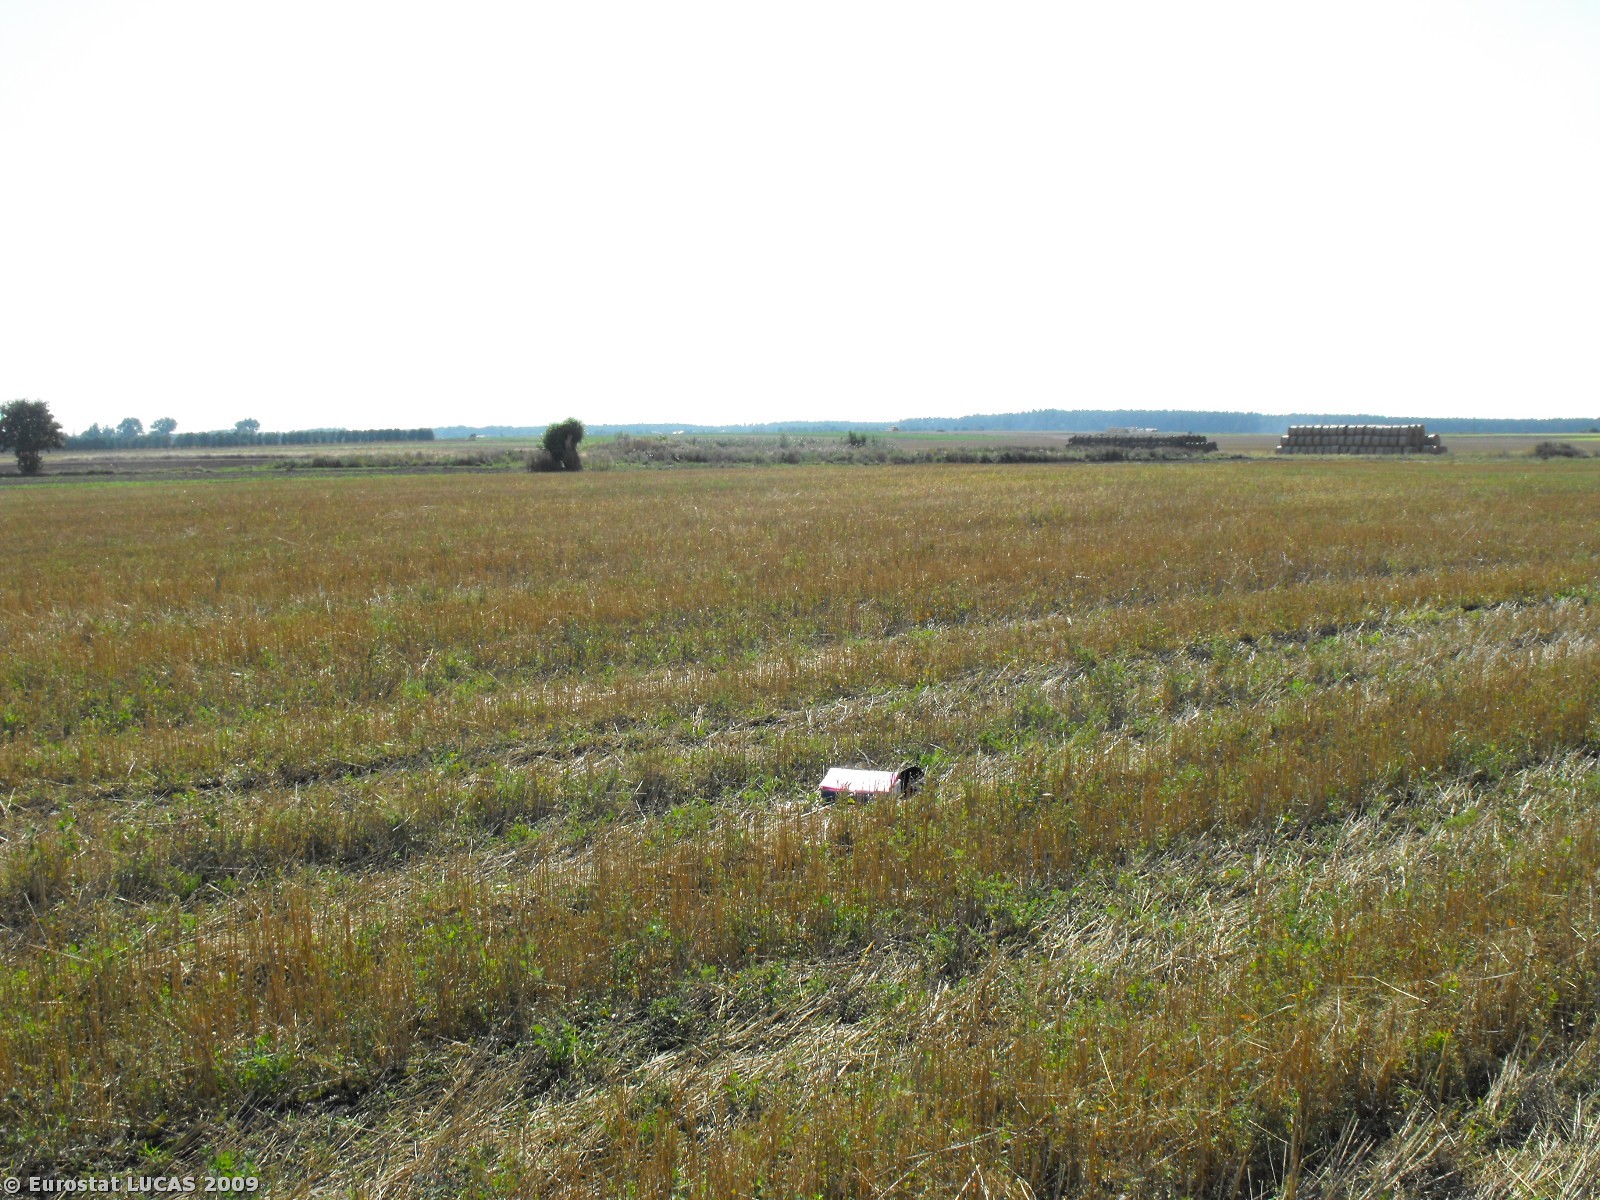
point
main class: Cropland
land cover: Triticale
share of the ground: < 10 %
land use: Agriculture (excluding fallow land and kitchen gardens)
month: September
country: PL
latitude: 52.3331
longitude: 16.3613
